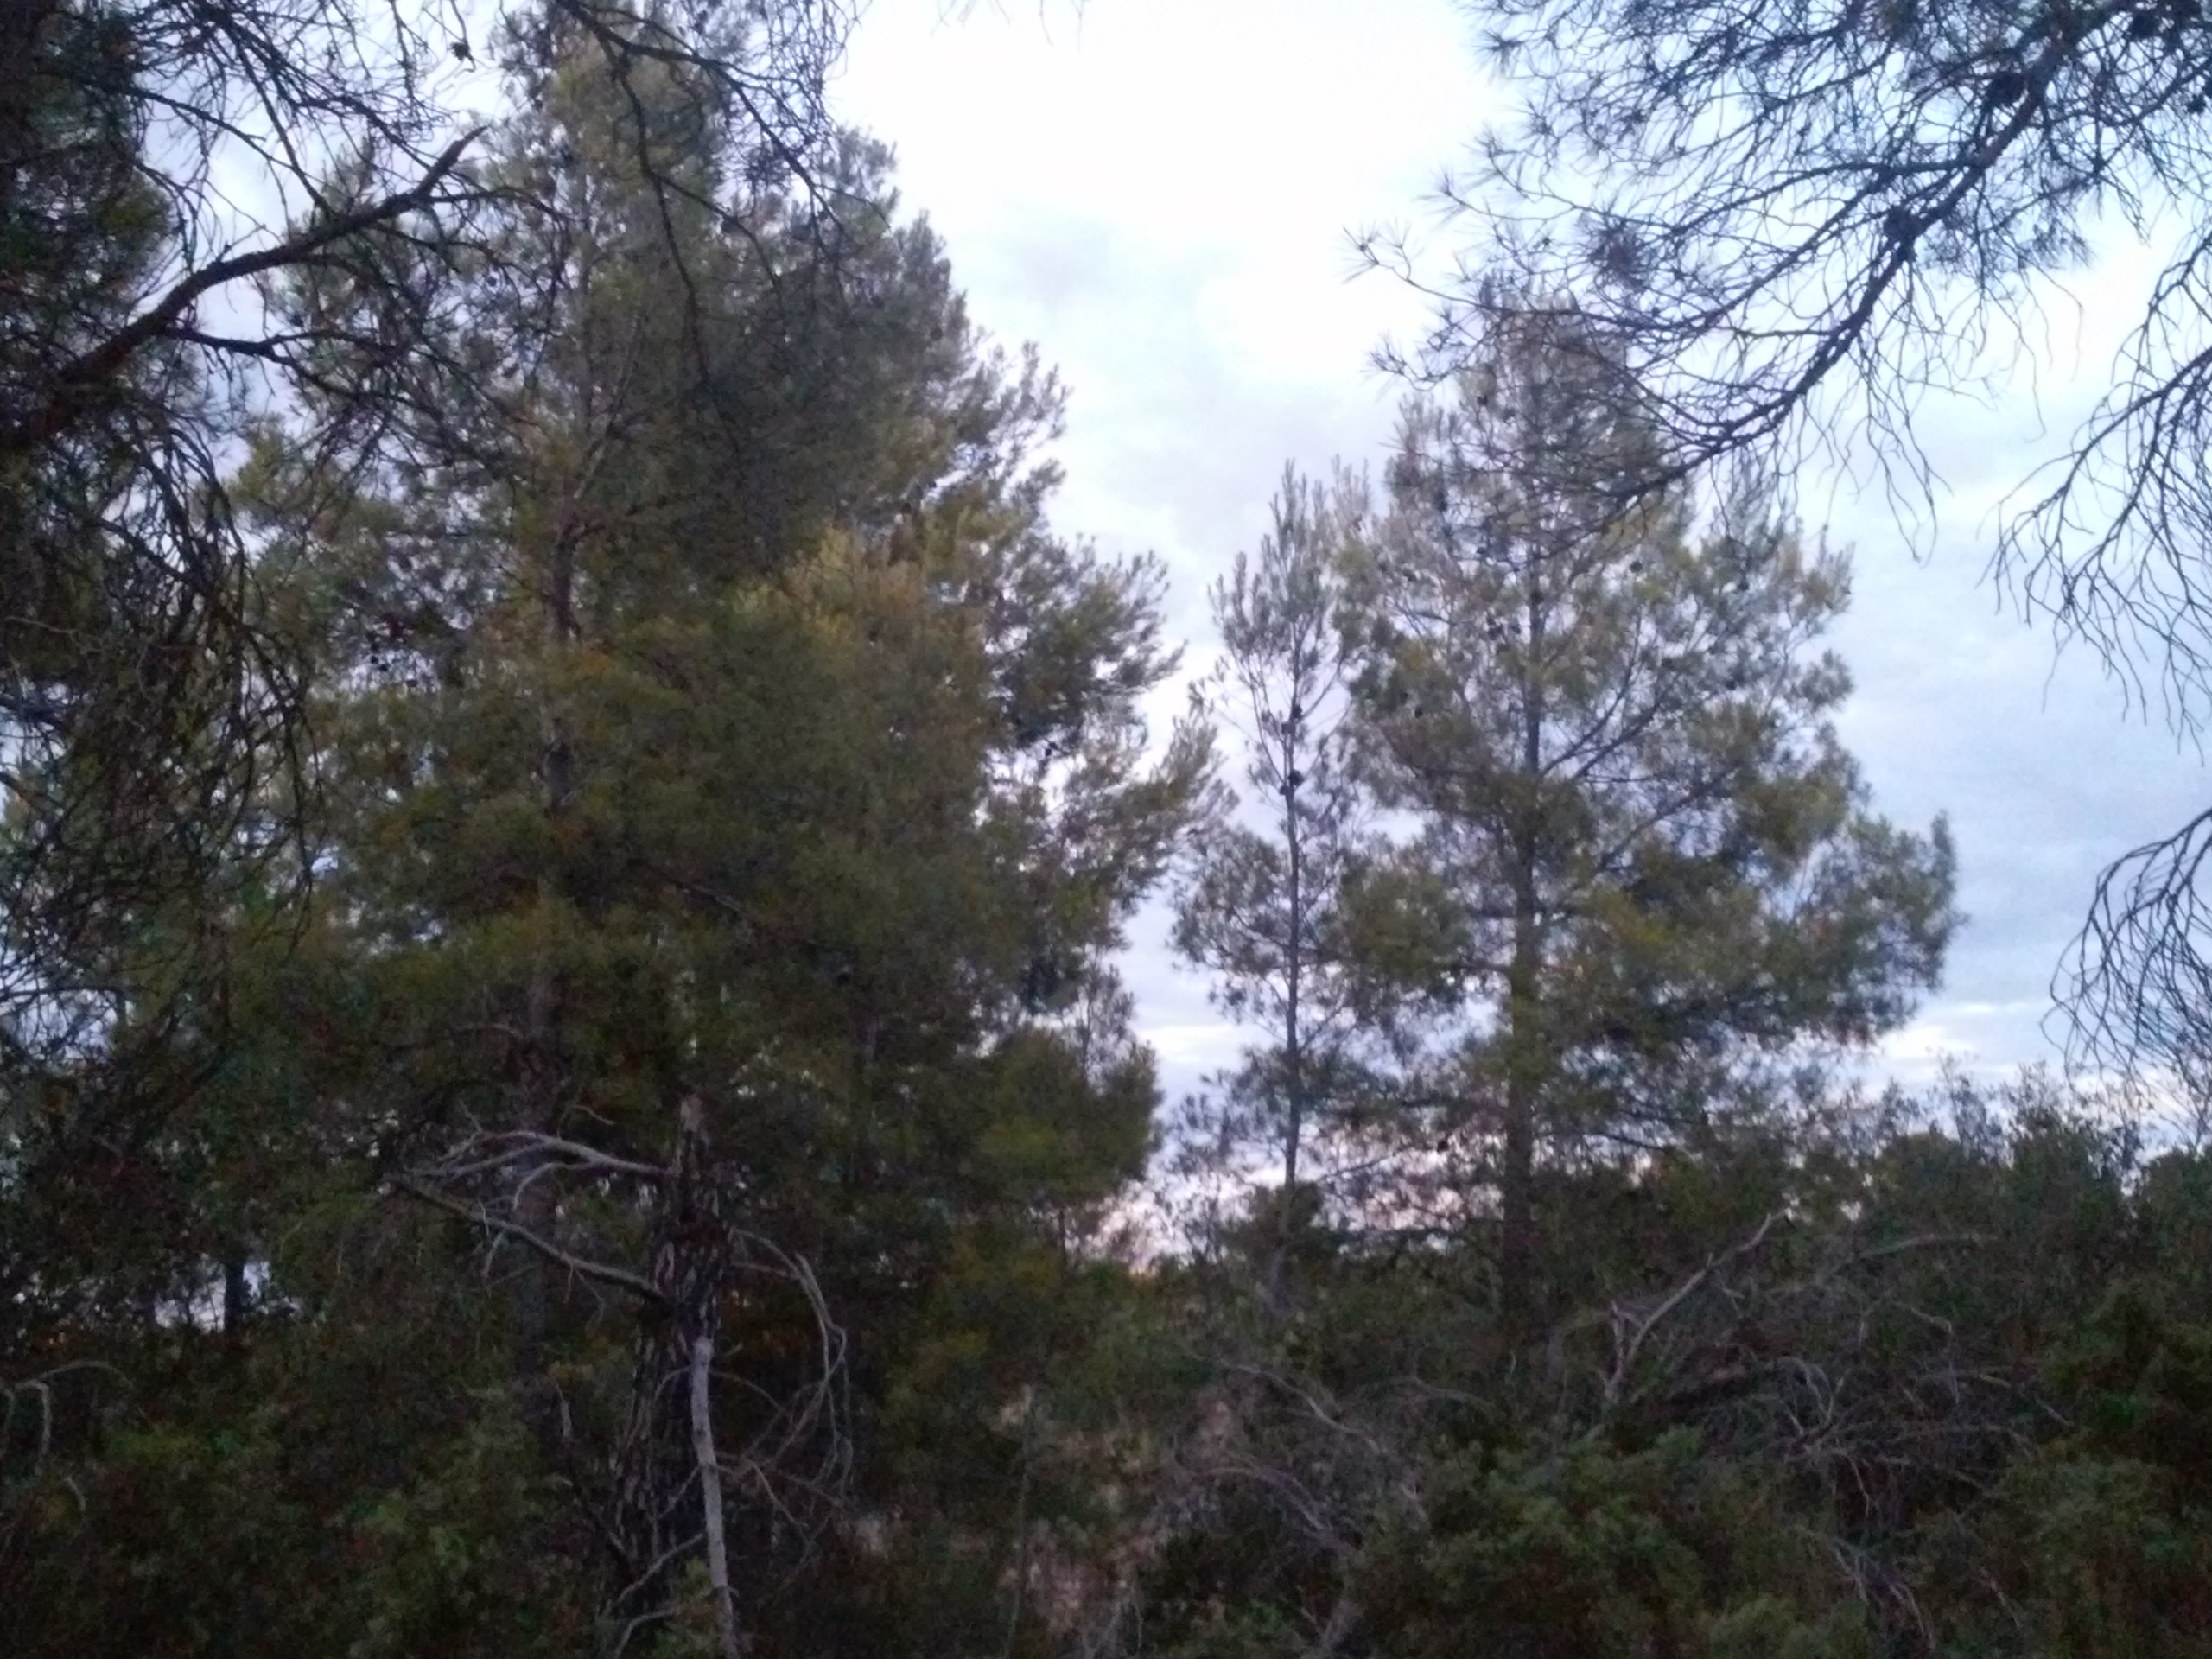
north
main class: Woodland
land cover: Pine dominated coniferous woodland
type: coniferous forest of the mediterranean region
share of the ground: 10 - 25 %
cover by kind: consolidated bare surface 30 %, shrubs 25 %, coniferous forest trees 20 %, herbaceous plants 20 %, broadleaved forest trees 5 %
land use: Semi-natural and natural areas not in use
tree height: < 5 m
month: August
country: ES
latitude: 41.4136
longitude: 0.7660
